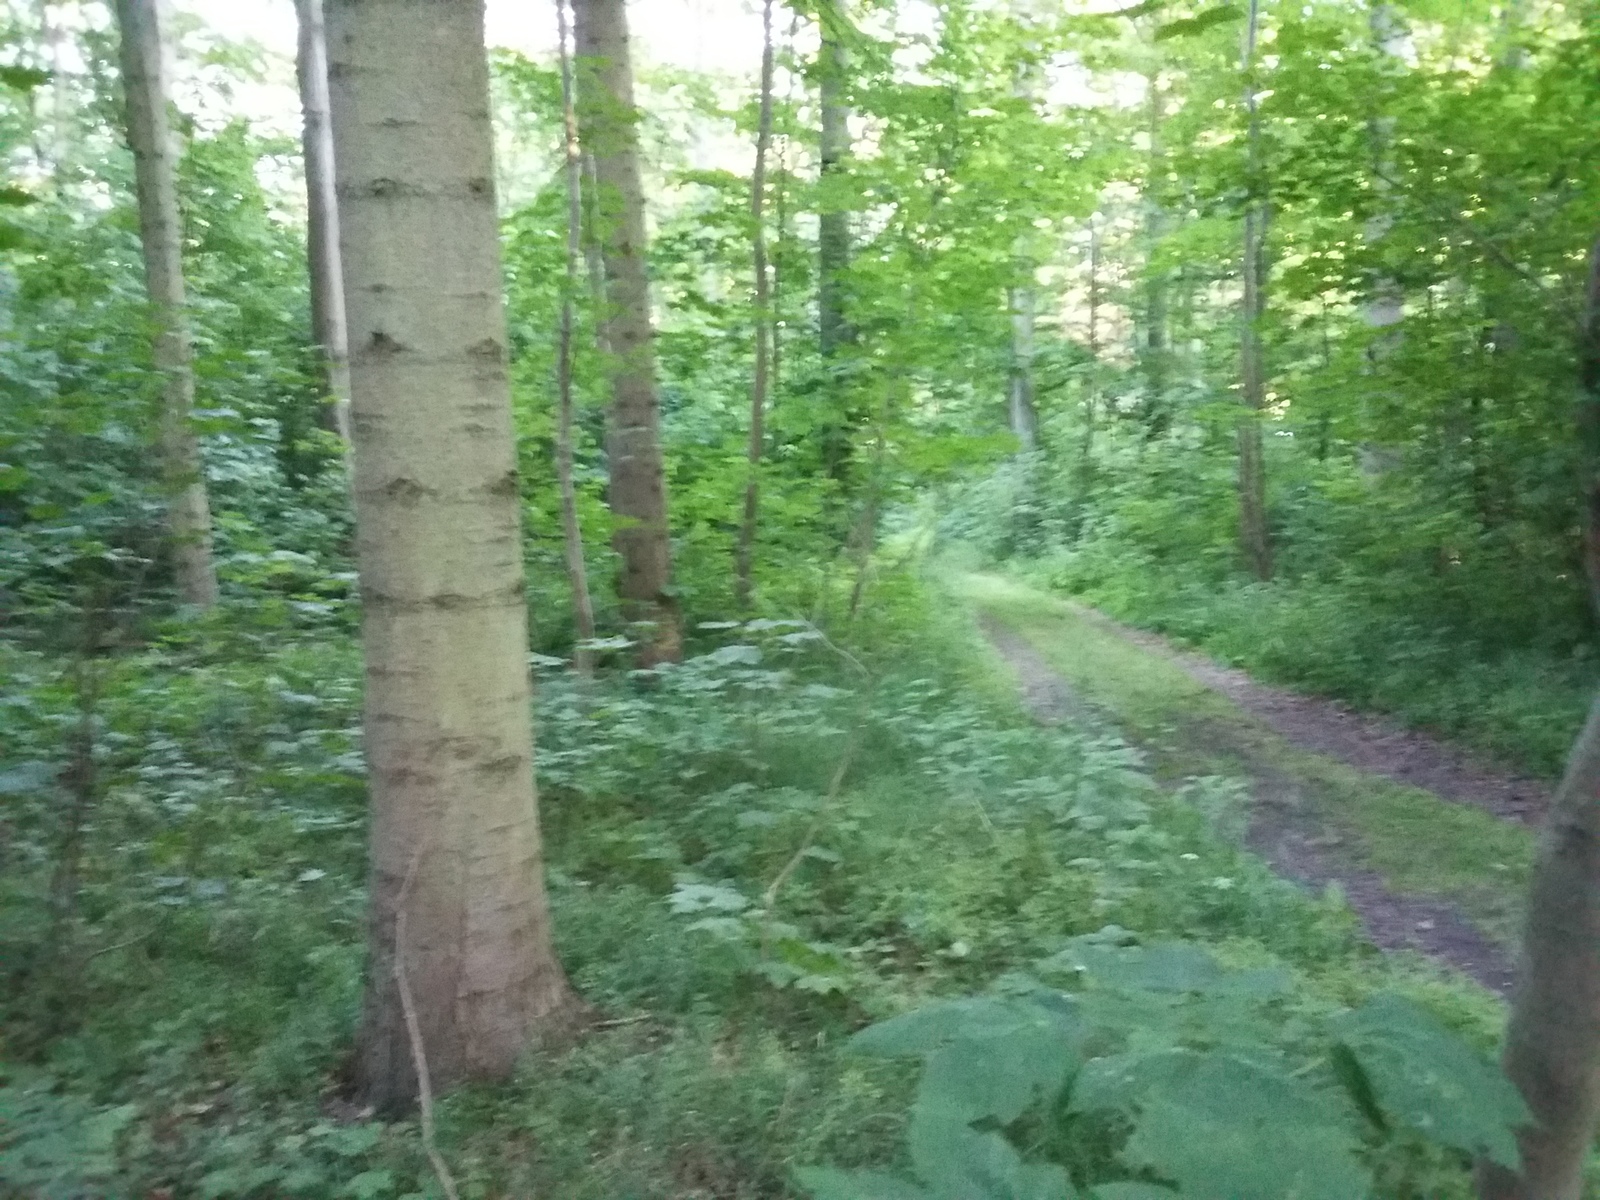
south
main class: Woodland
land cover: Spruce dominated mixed woodland
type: thermophilous deciduous forest
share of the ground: > 75 %
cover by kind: coniferous forest trees 65 %, broadleaved forest trees 25 %, herbaceous plants 10 %
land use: Forestry
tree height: > 5 m
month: July
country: DK
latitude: 54.9673
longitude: 12.0137
